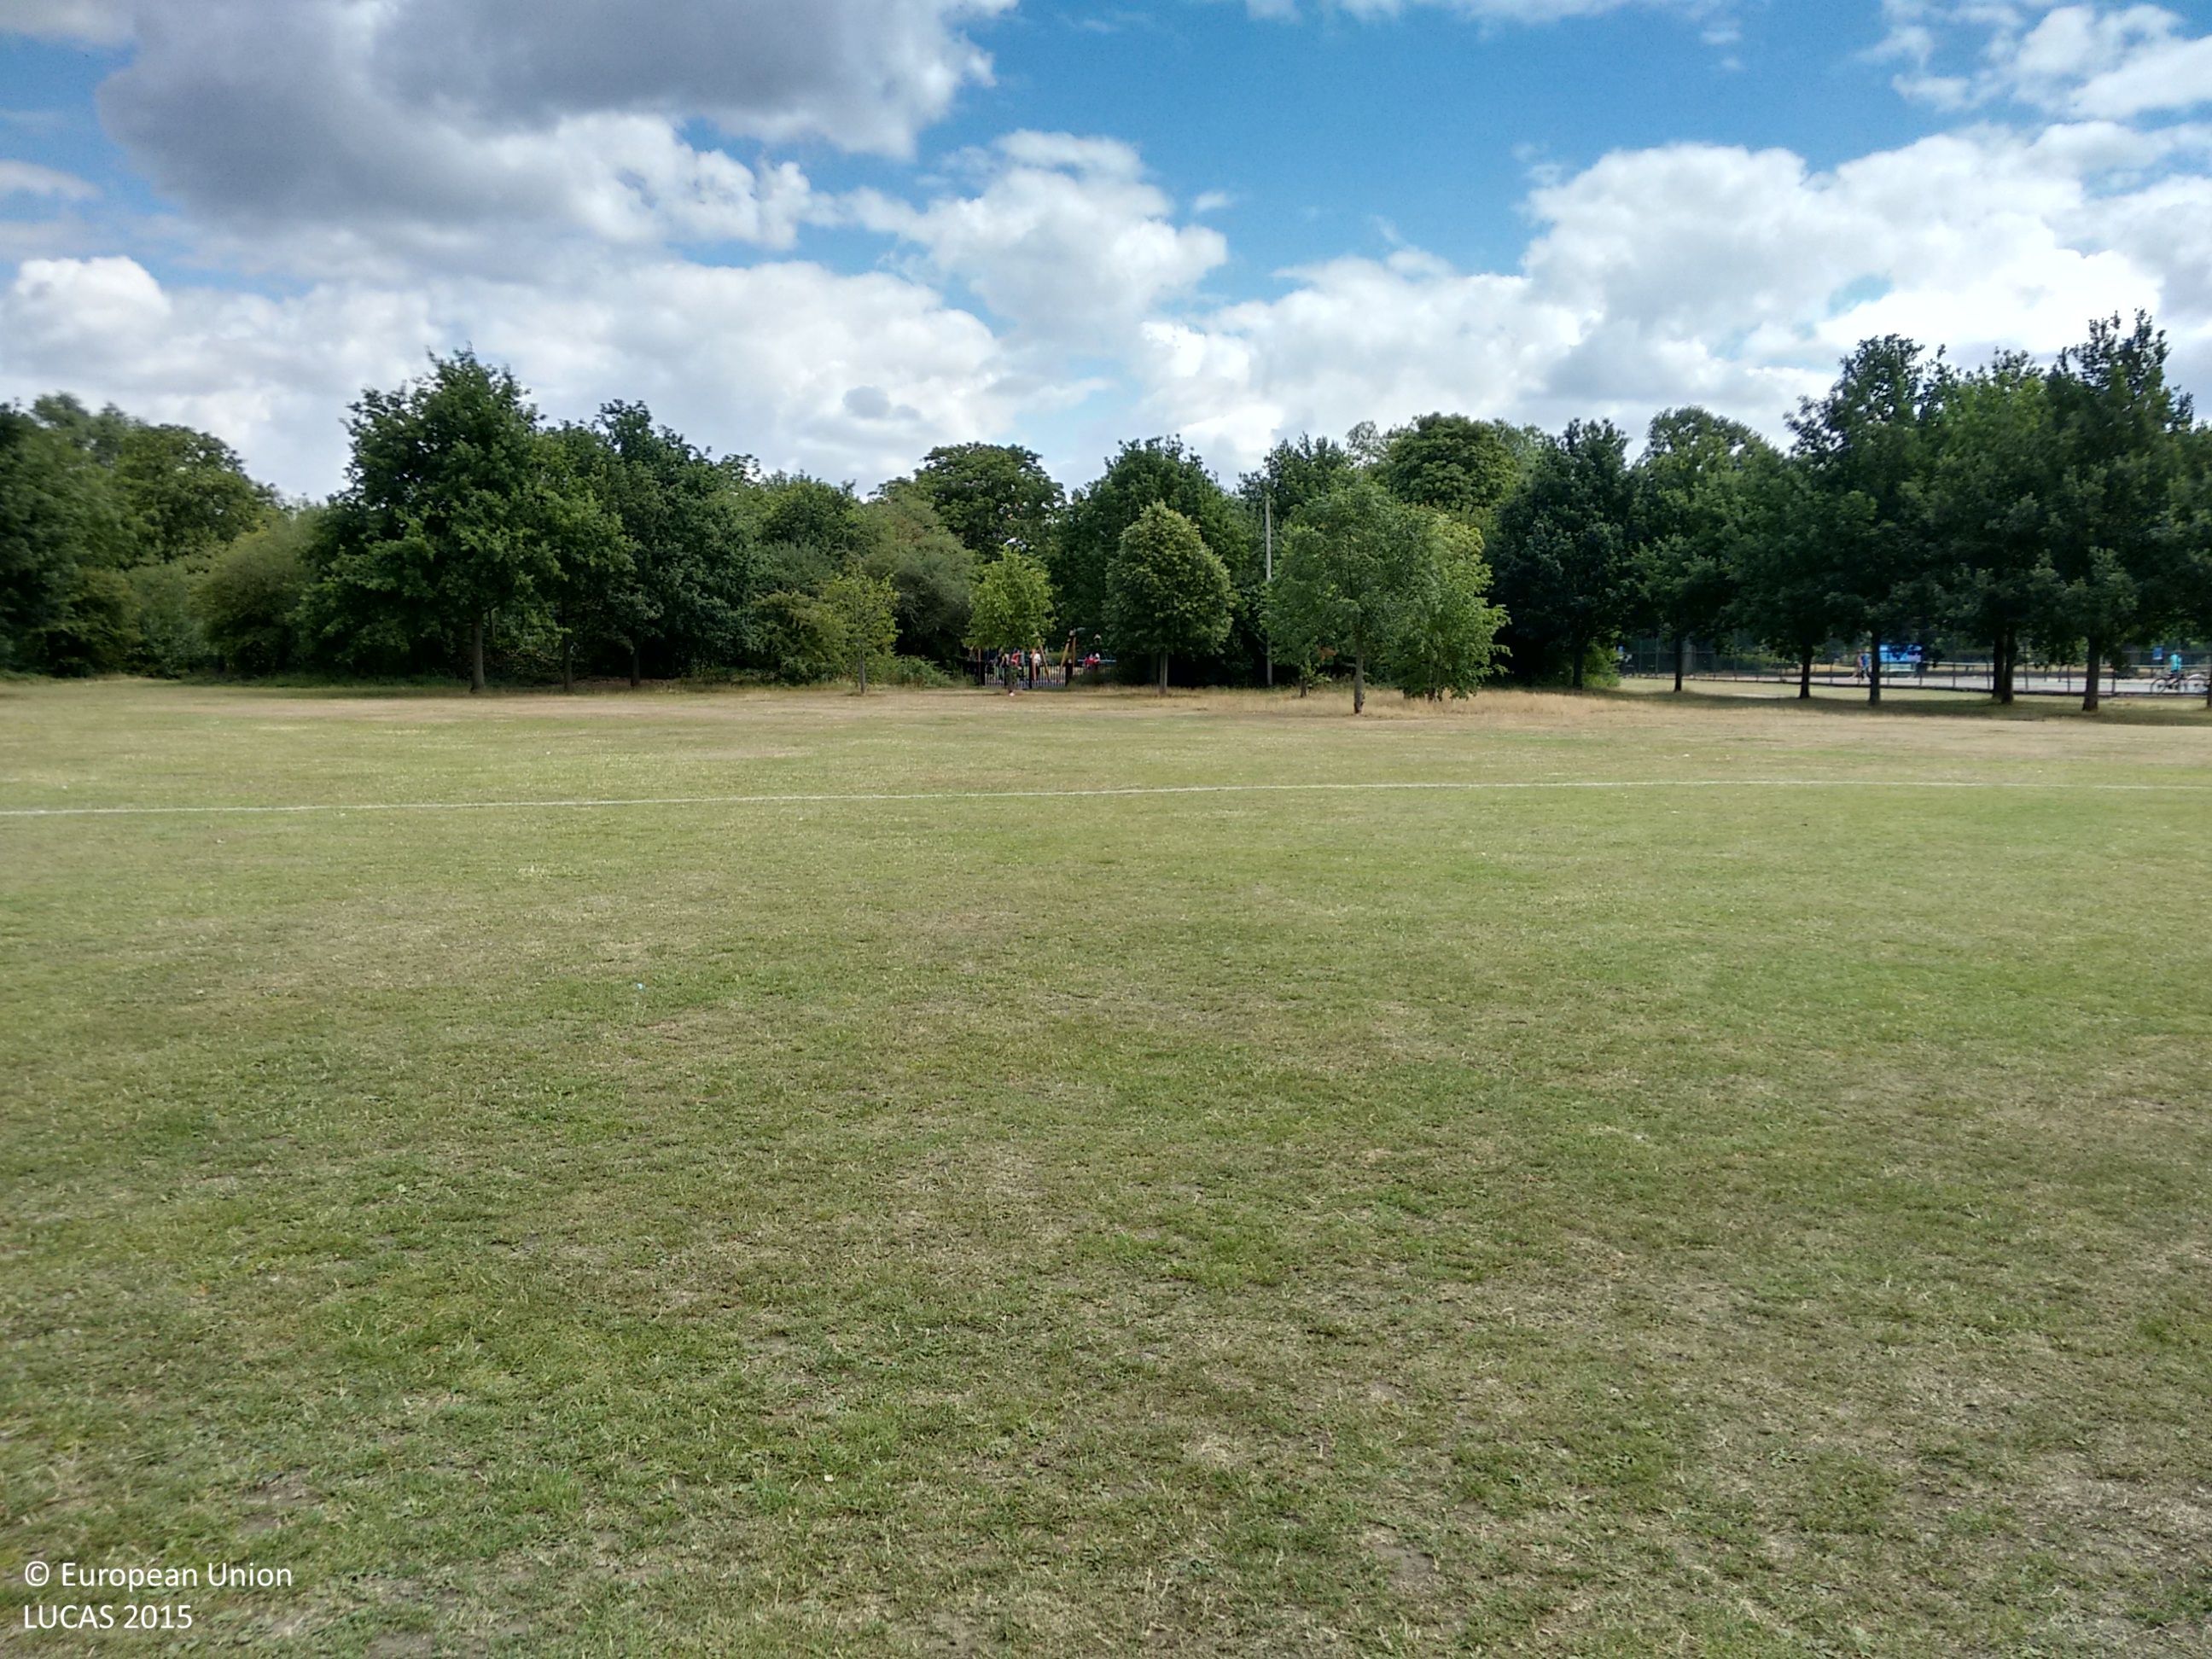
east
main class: Grassland
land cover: Grassland without tree/shrub cover
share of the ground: > 75 %
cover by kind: herbaceous plants 100 %
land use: Amenities, museums, leisure
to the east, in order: Grassland without tree/shrub cover; Broadleaved woodland; Artificial constructions in urban areas; Lines of trees; Tracks; Broadleaved woodland; Grassland without tree/shrub cover; Tracks; Grassland with sparse tree/shrub cover; Tracks; Grassland without tree/shrub cover
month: July
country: GB
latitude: 51.4341
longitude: -0.1469
